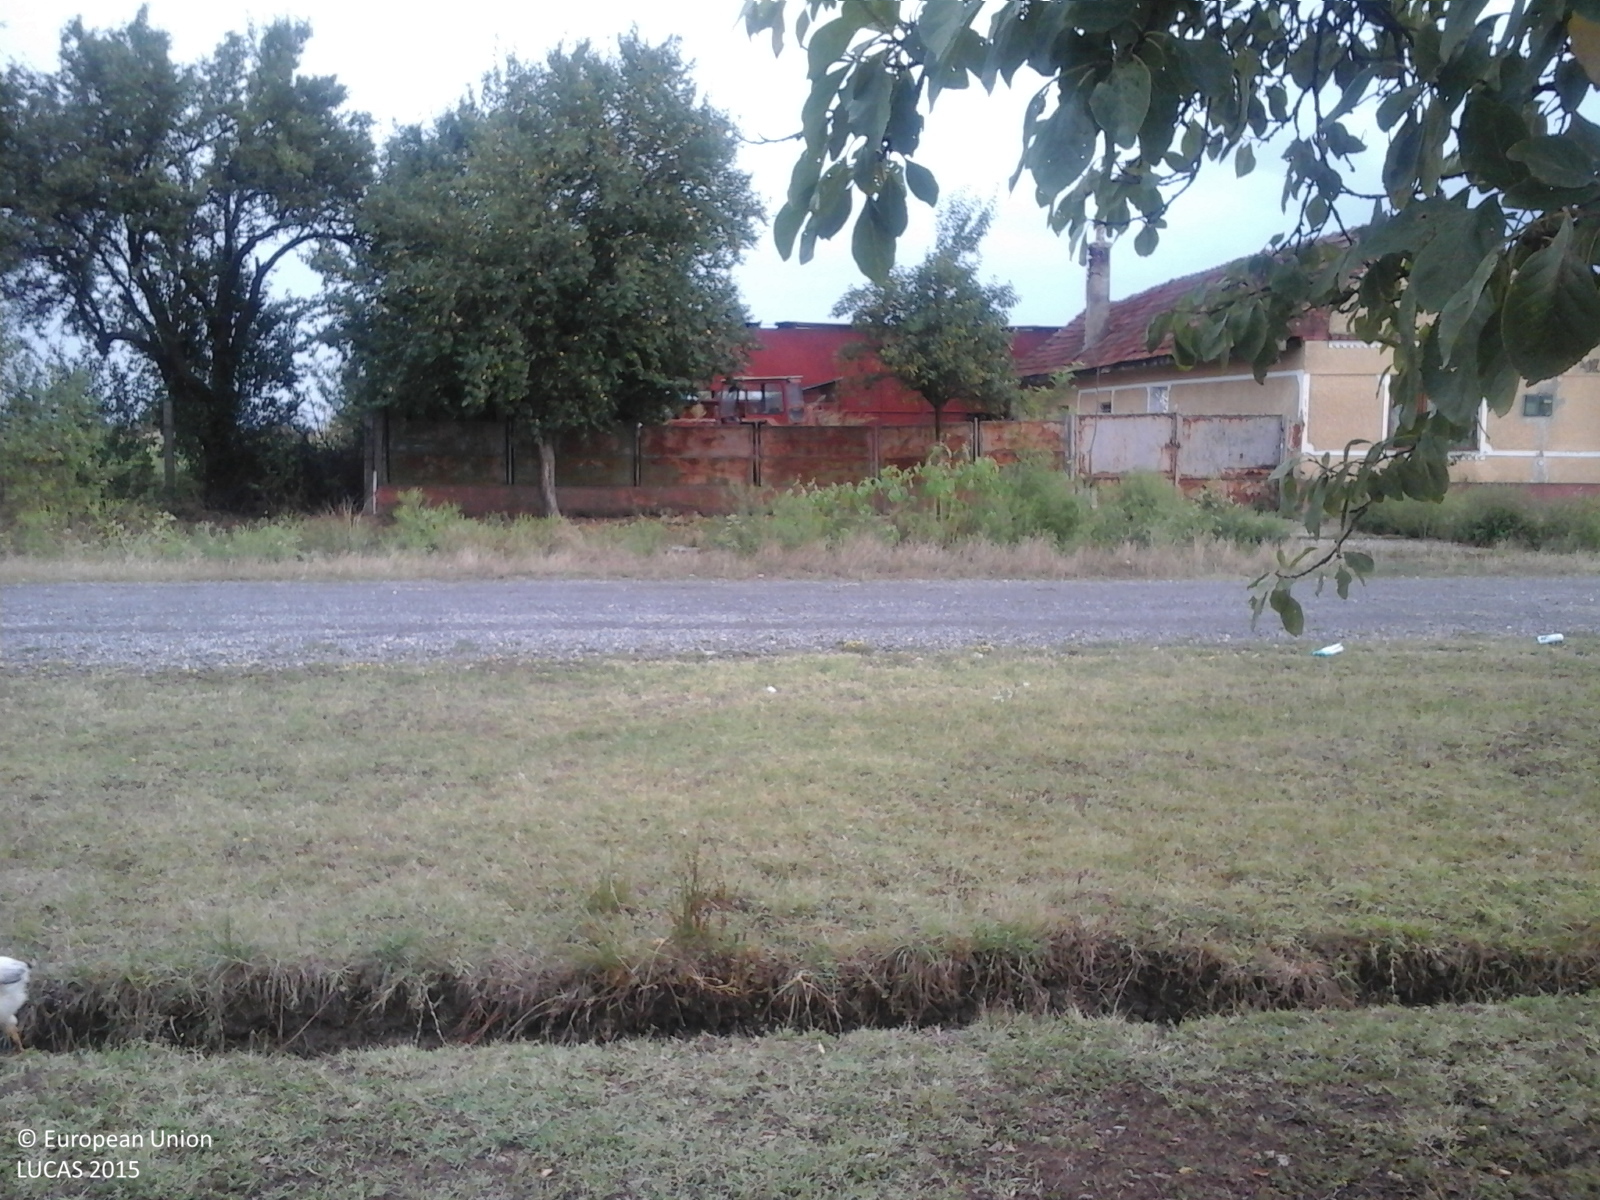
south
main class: Cropland
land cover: Other fruit trees and berries
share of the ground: > 75 %
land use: Agriculture (excluding fallow land and kitchen gardens)
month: August
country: RO
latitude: 45.7821
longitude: 21.6762
